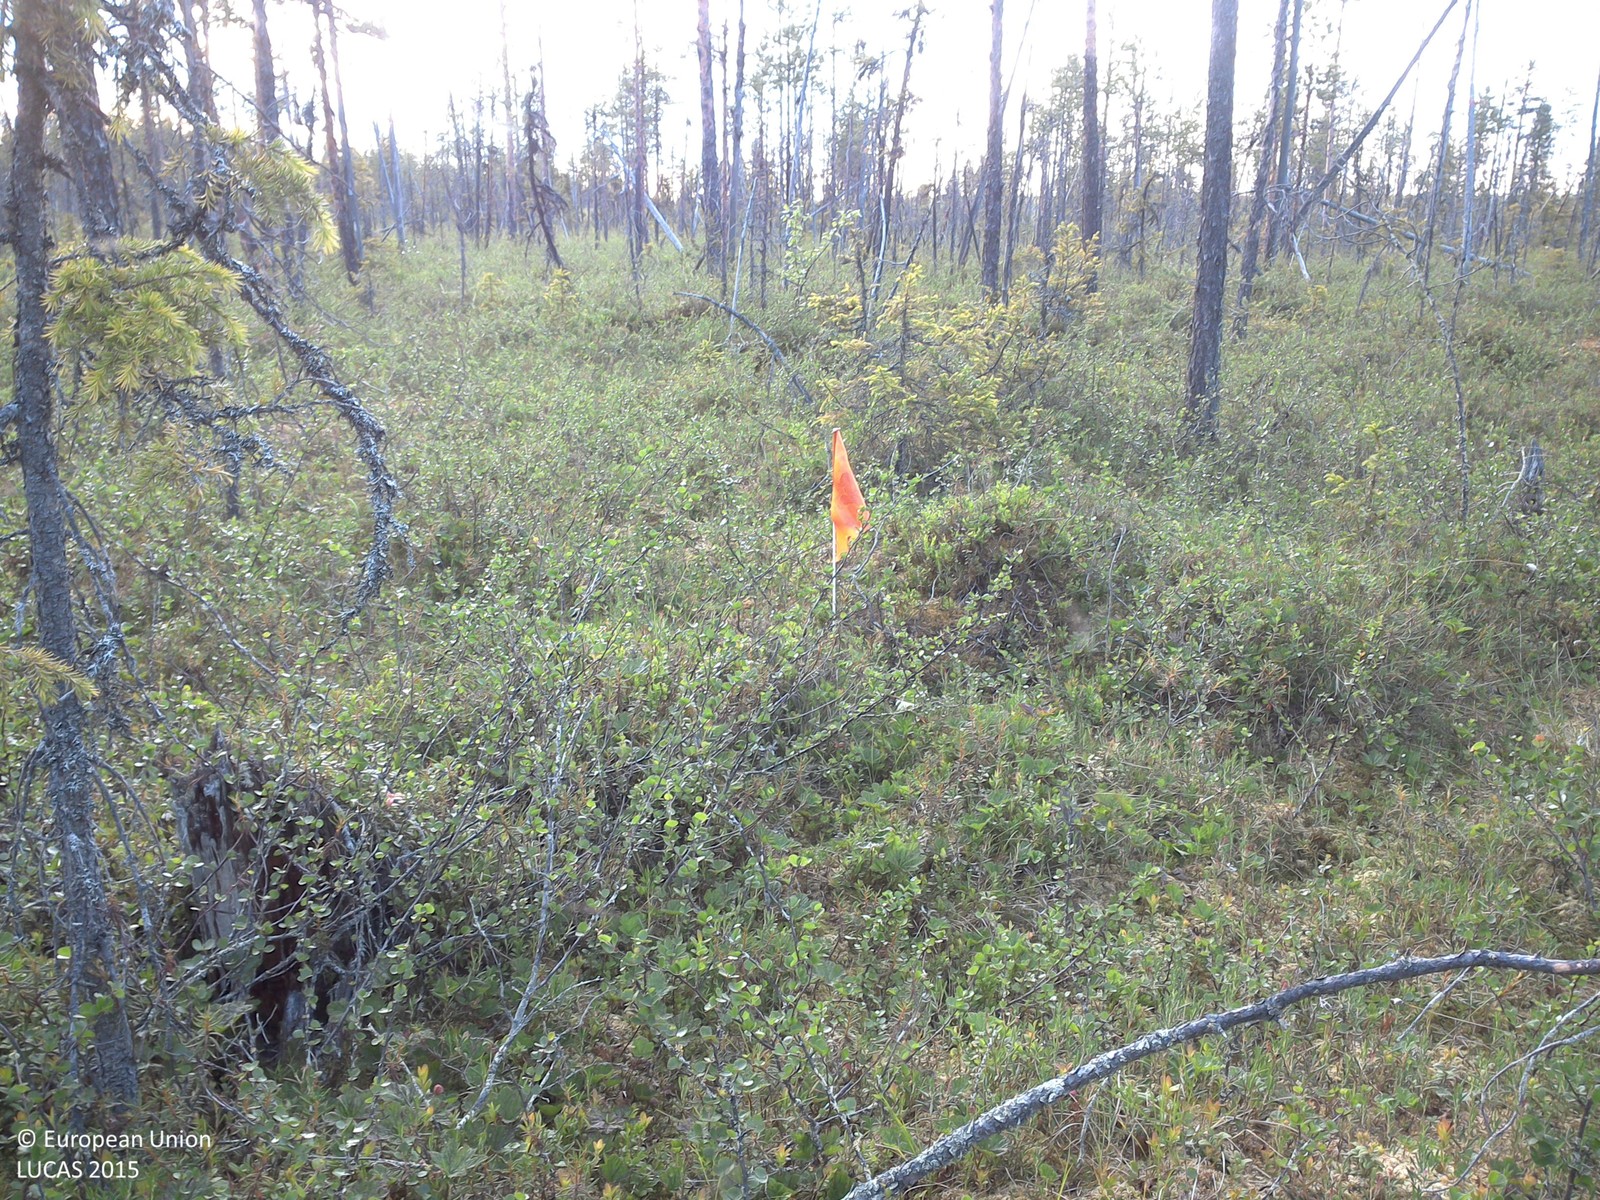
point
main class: Woodland
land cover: Pine dominated coniferous woodland
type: boreal forest
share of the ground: 10 - 25 %
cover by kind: shrubs 40 %, lichens and mosses 25 %, herbaceous plants 20 %, coniferous forest trees 15 %
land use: Semi-natural and natural areas not in use
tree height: > 5 m
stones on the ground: < 10 %
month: July
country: SE
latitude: 67.0761
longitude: 22.7815
